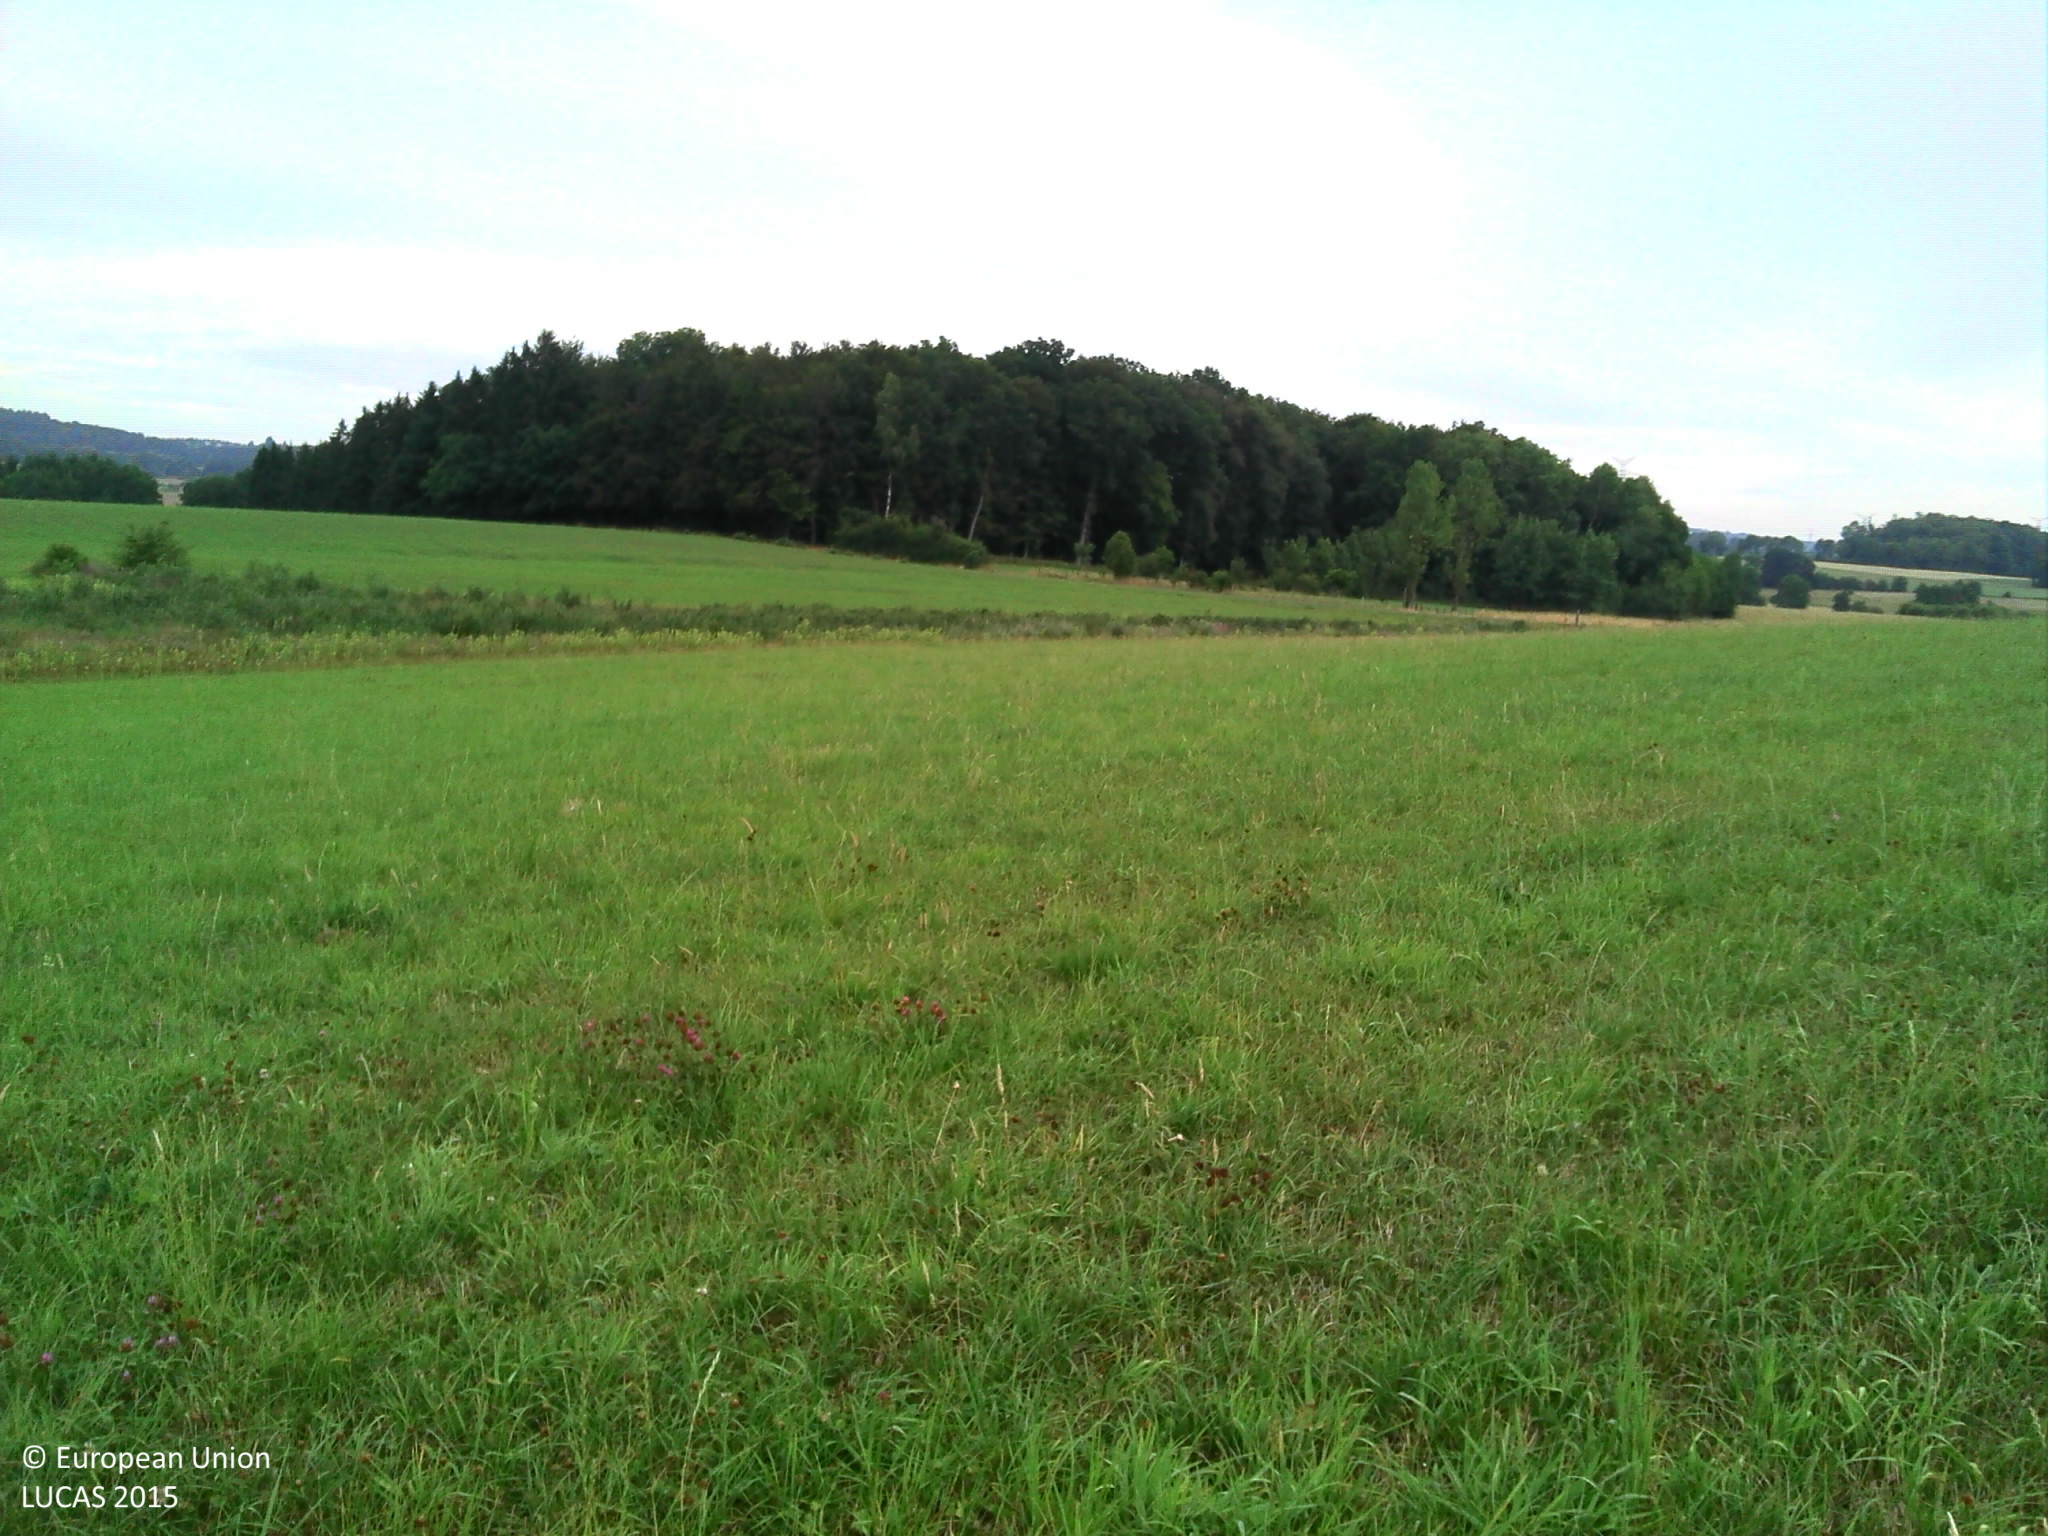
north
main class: Grassland
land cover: Grassland without tree/shrub cover
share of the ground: > 75 %
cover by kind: herbaceous plants 100 %
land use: Agriculture (excluding fallow land and kitchen gardens)
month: July
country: BE
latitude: 49.7265
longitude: 5.7400
